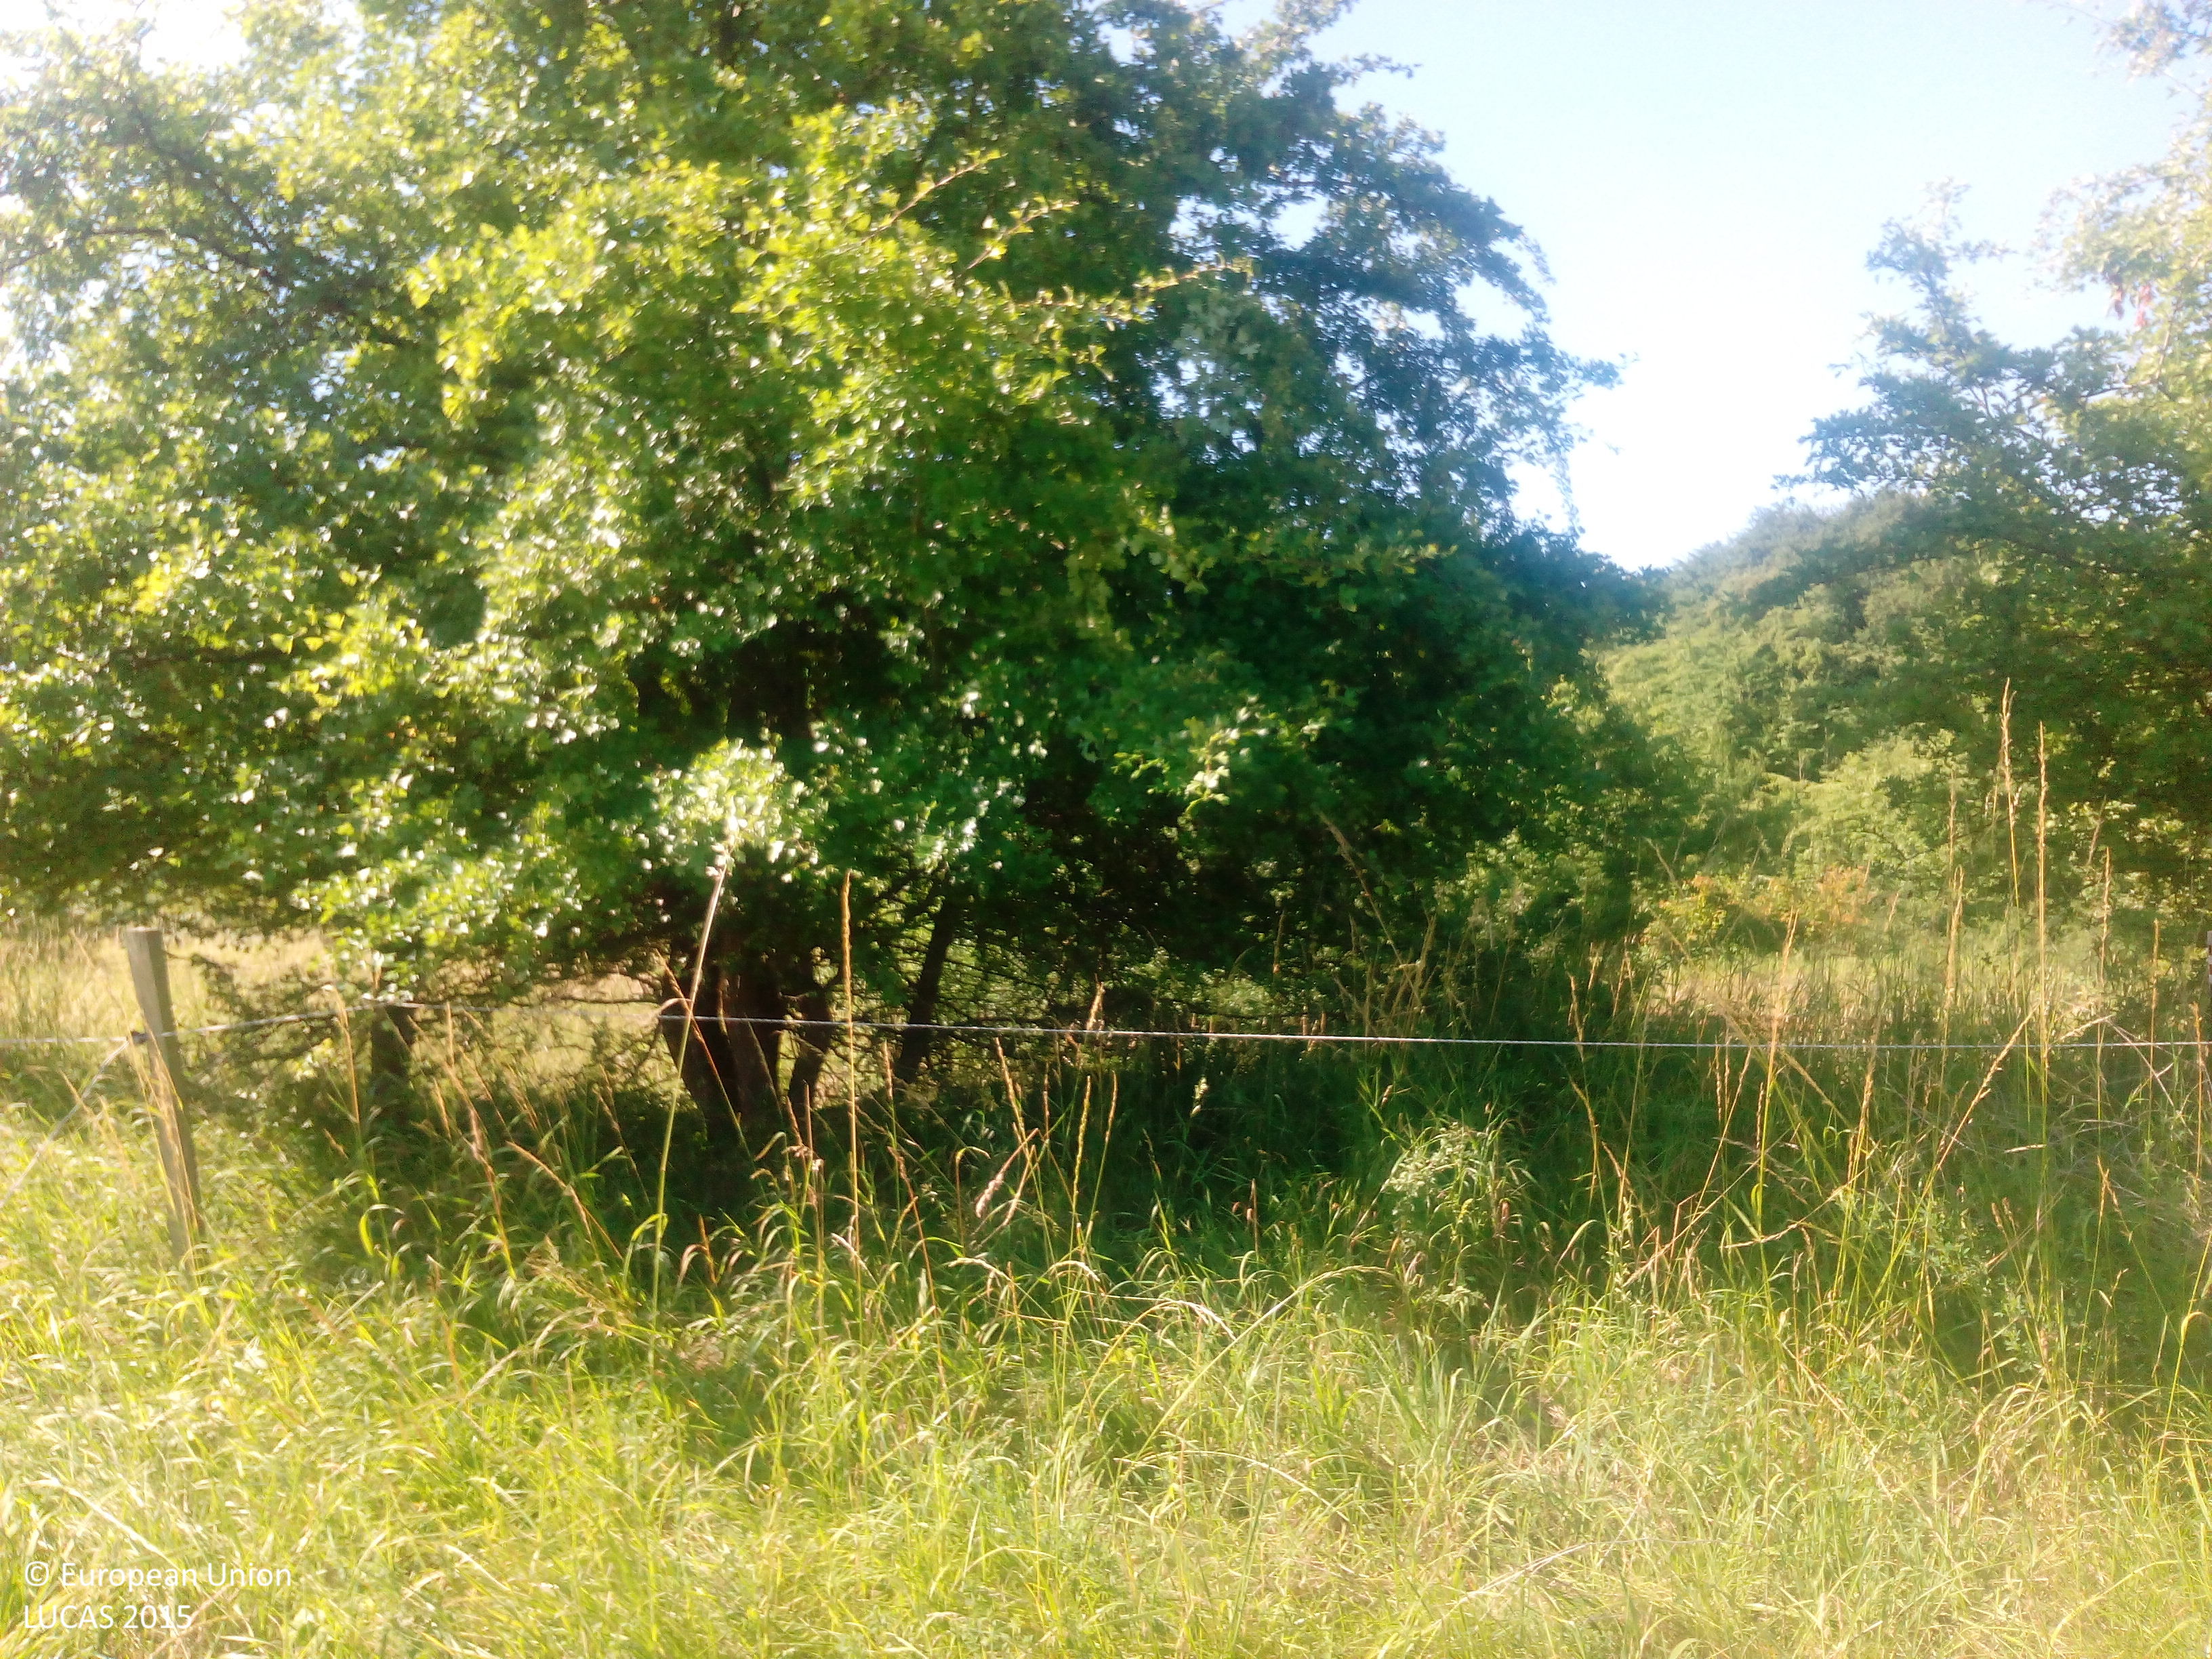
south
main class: Artificial land
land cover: Other artificial areas
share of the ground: > 75 %
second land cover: Grassland with sparse tree/shrub cover
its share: > 75 %
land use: Electricity, gas and thermal power distribution
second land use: Agriculture (excluding fallow land and kitchen gardens)
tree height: > 5 m
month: July
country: DE
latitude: 51.6944
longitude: 9.9566
